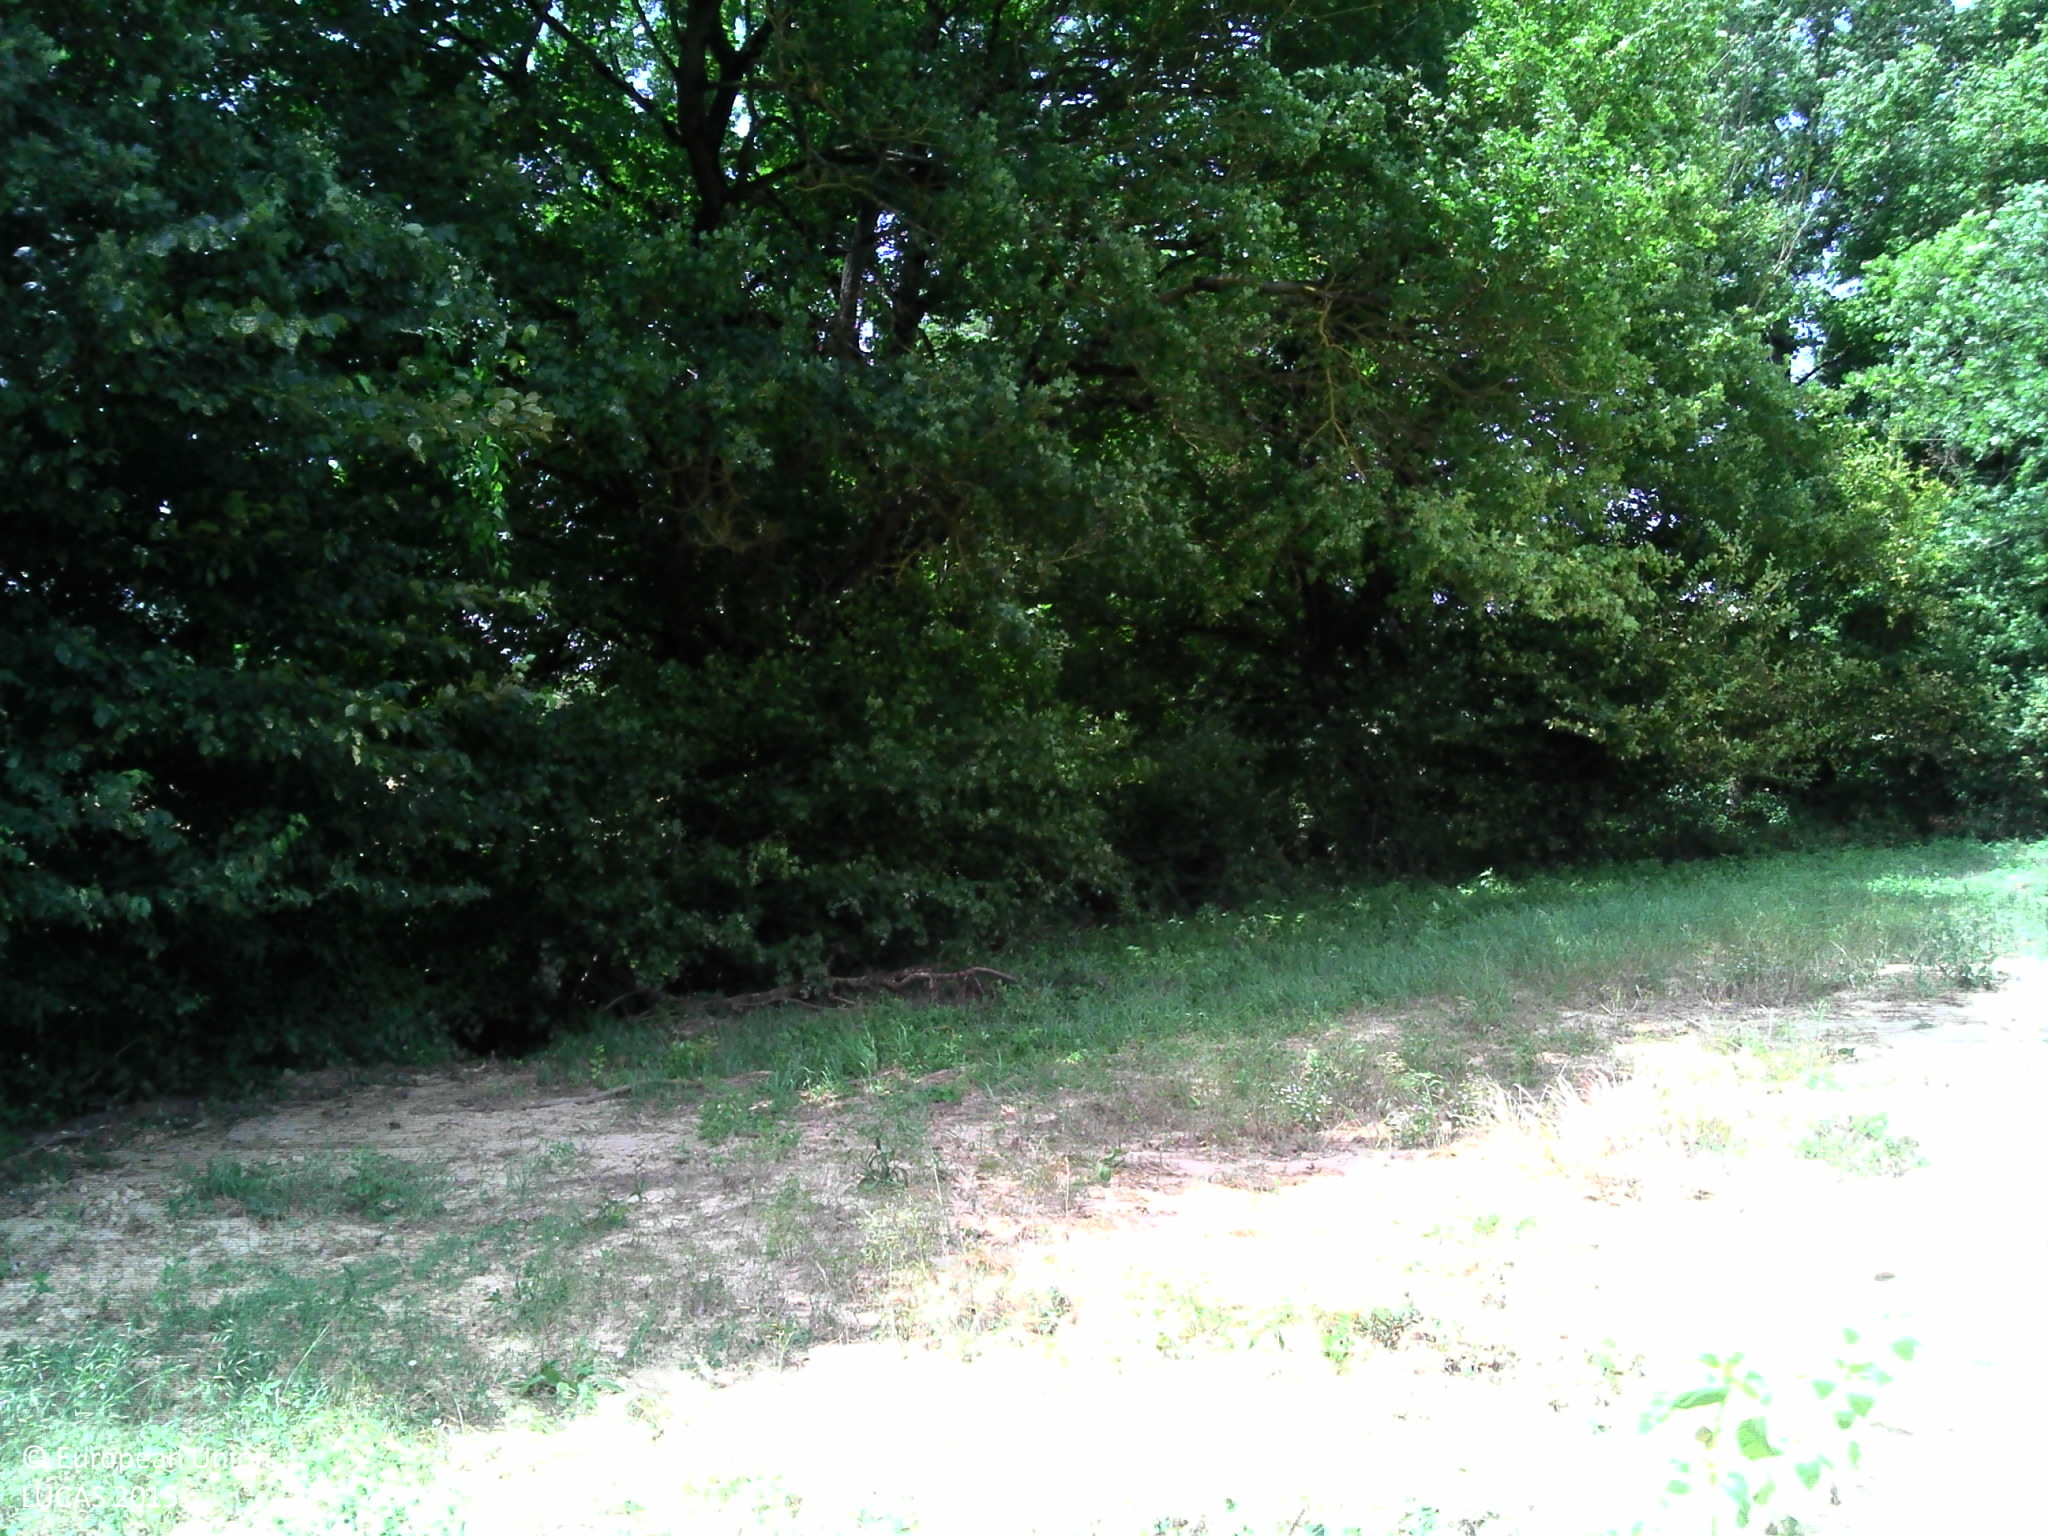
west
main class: Cropland
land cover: Sunflower
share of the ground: > 75 %
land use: Agriculture (excluding fallow land and kitchen gardens)
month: July
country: FR
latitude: 43.5282
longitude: 1.0552
